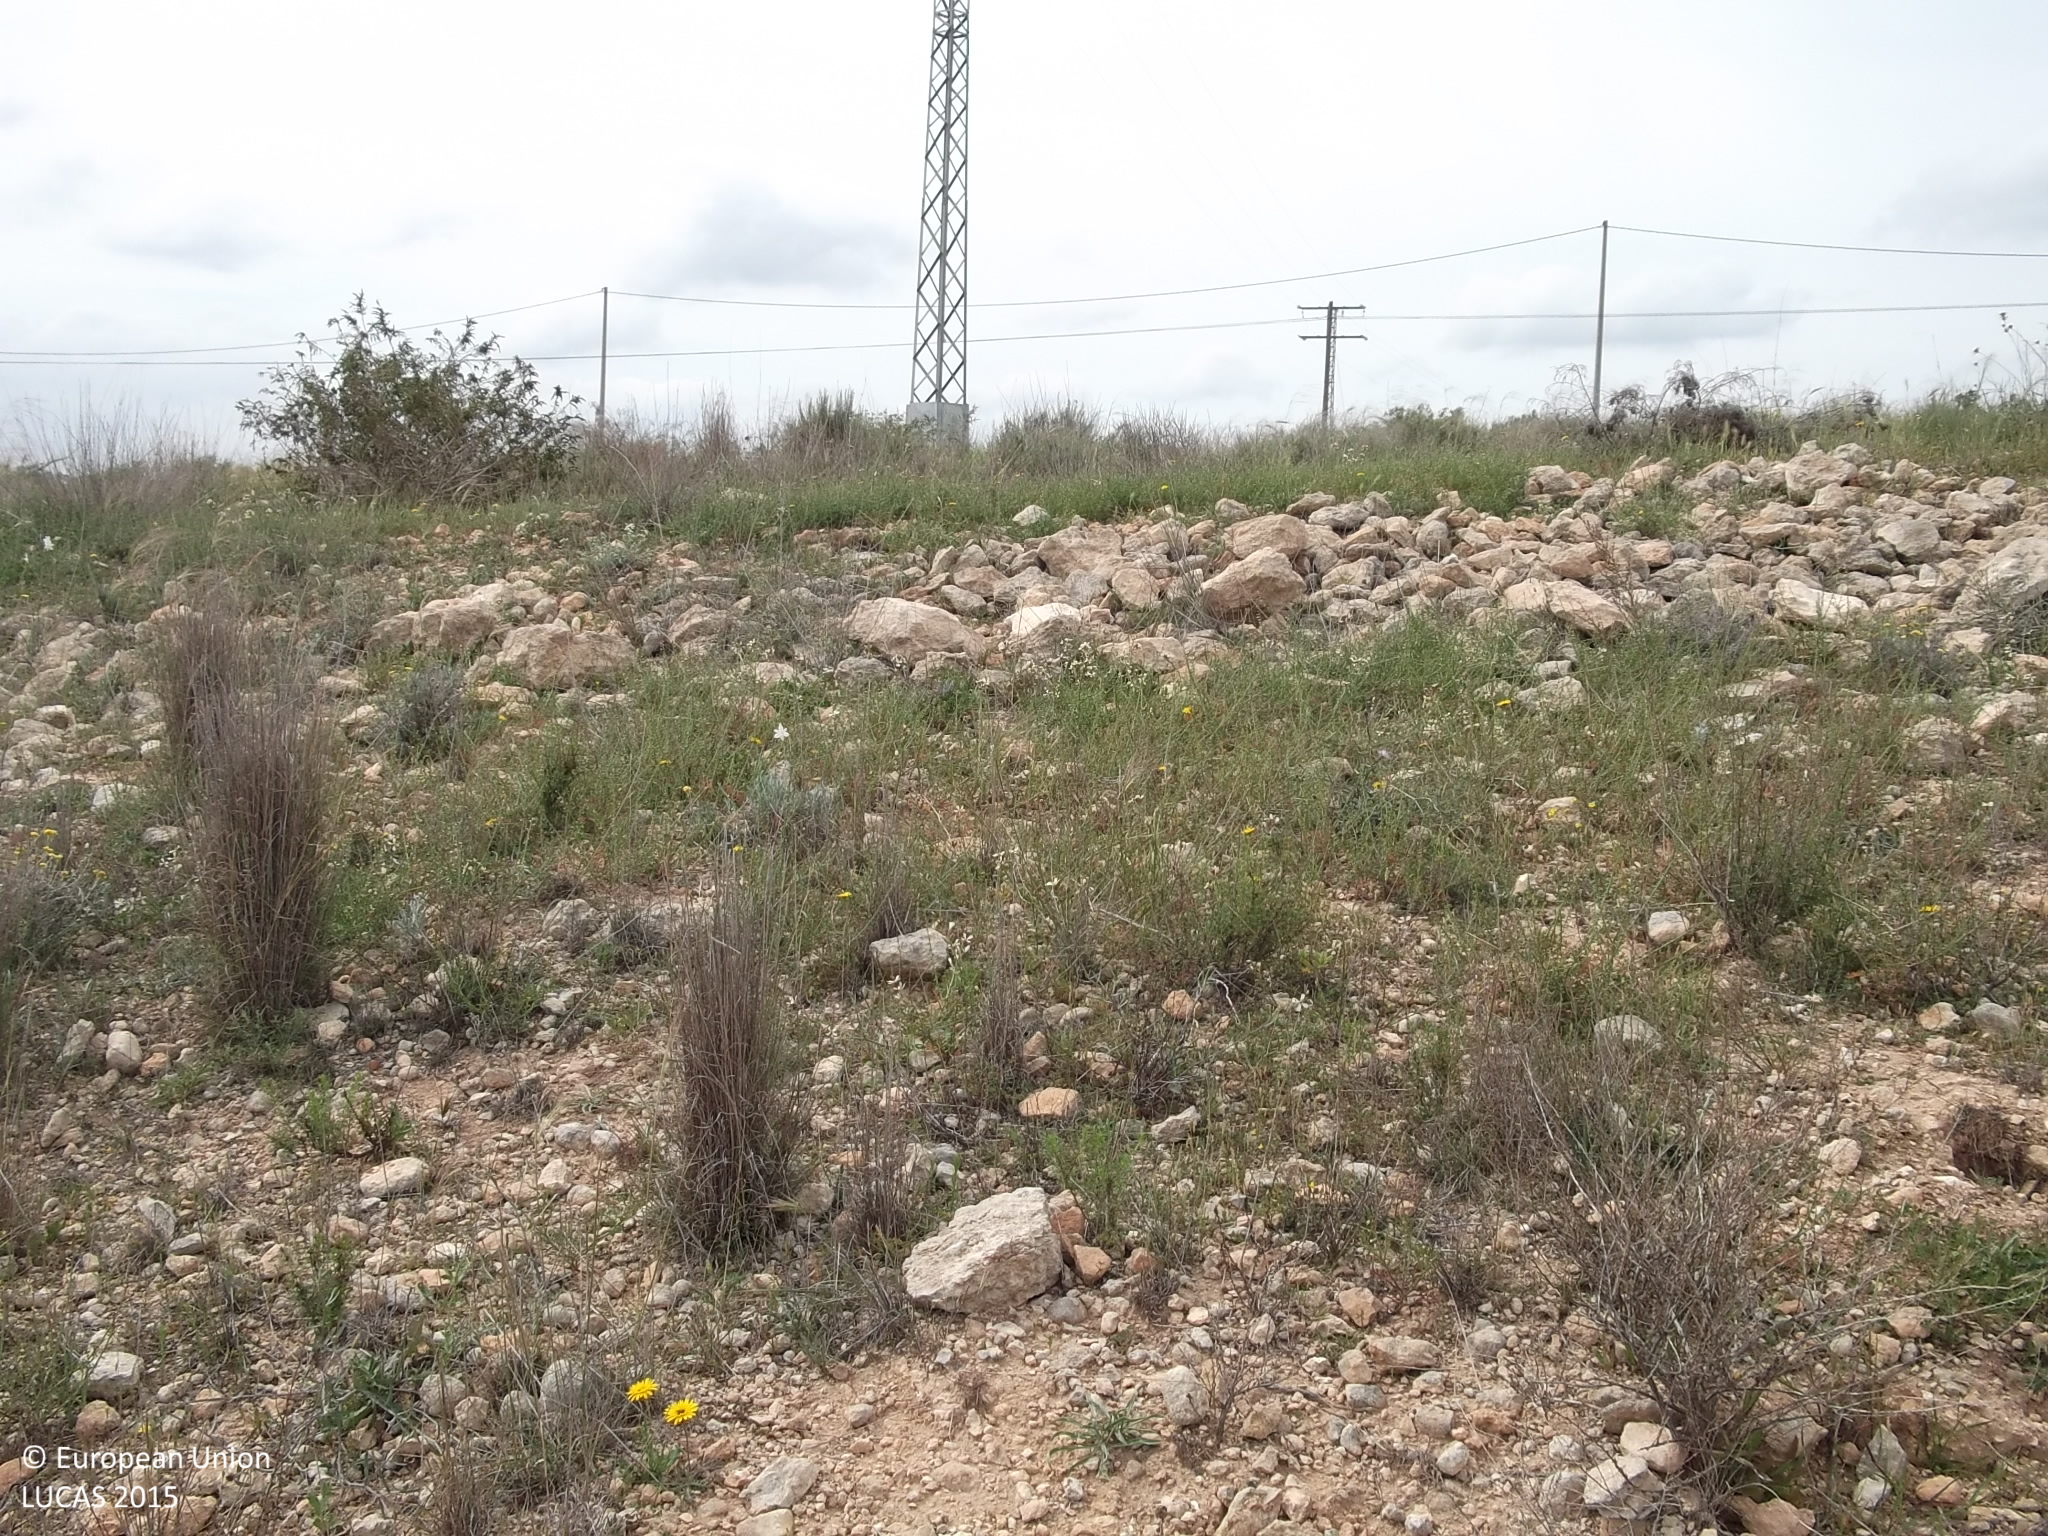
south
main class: Shrubland
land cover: Shrubland without tree cover
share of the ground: 25 - 50 %
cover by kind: herbaceous plants 40 %, shrubs 30 %, consolidated bare surface 30 %
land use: Semi-natural and natural areas not in use
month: April
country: ES
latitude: 37.9408
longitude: -1.3746
